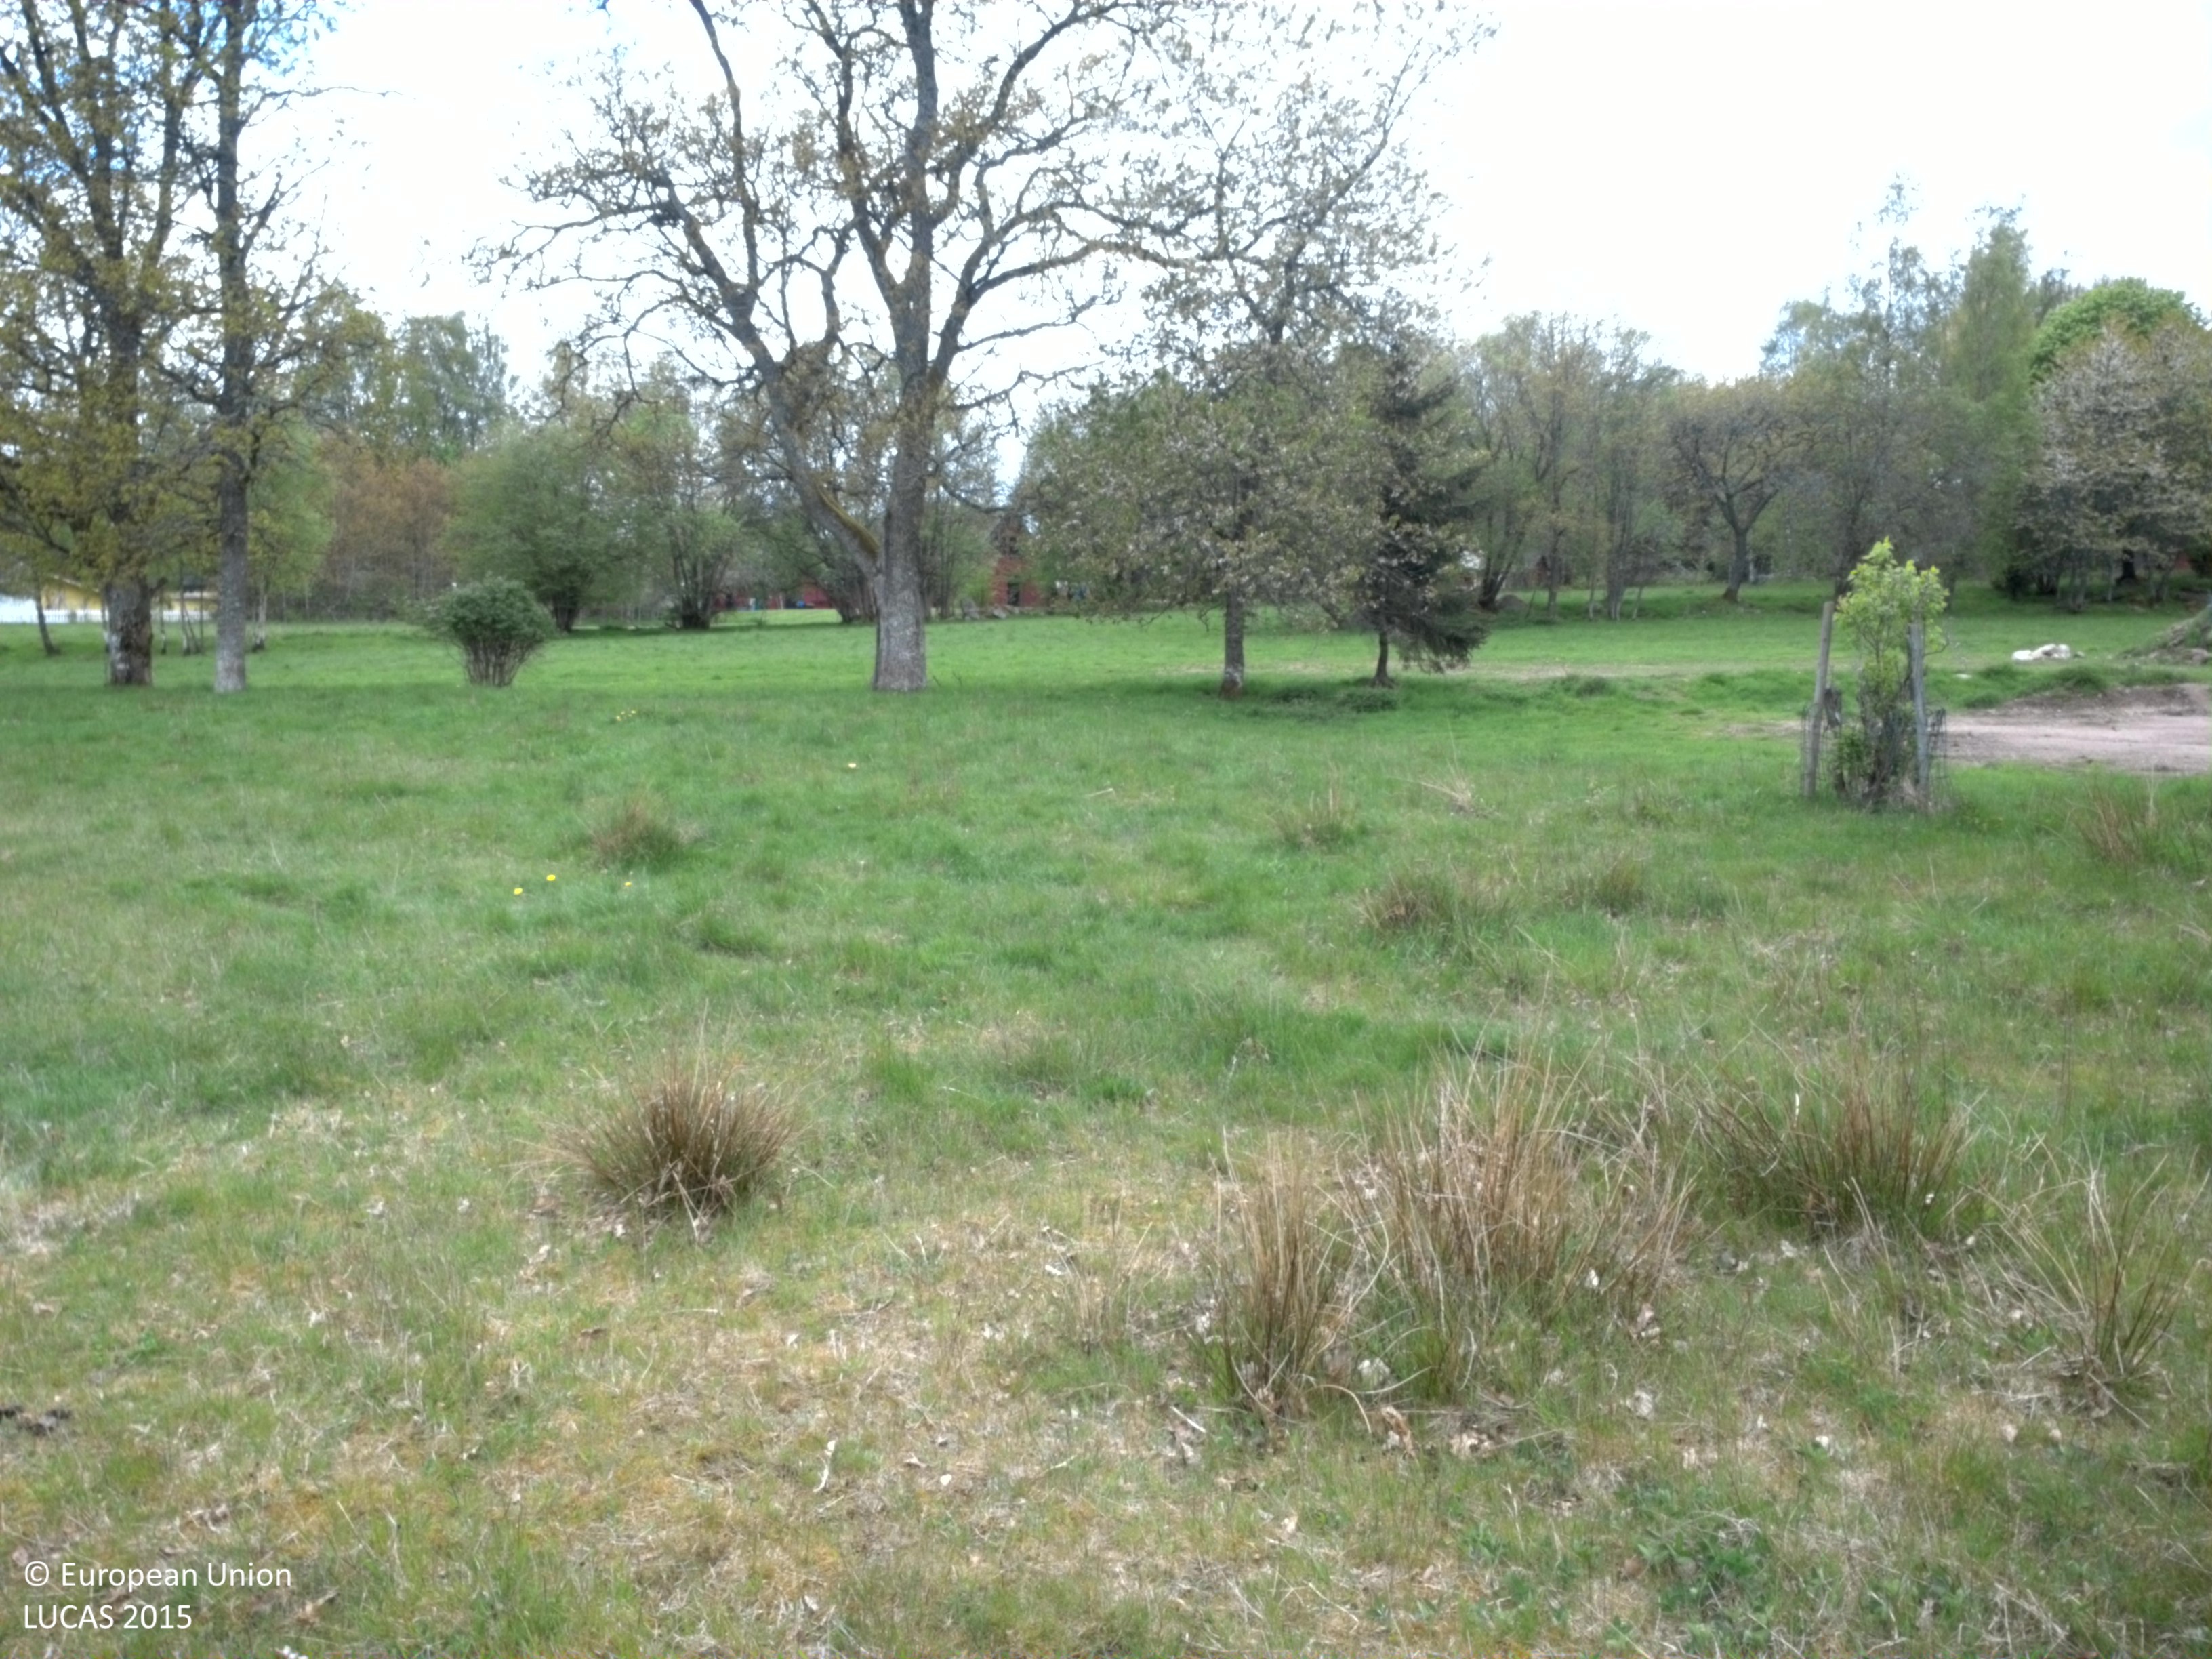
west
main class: Grassland
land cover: Grassland without tree/shrub cover
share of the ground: > 75 %
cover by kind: herbaceous plants 100 %
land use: Agriculture (excluding fallow land and kitchen gardens)
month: May
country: SE
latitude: 56.7984
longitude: 15.3197
